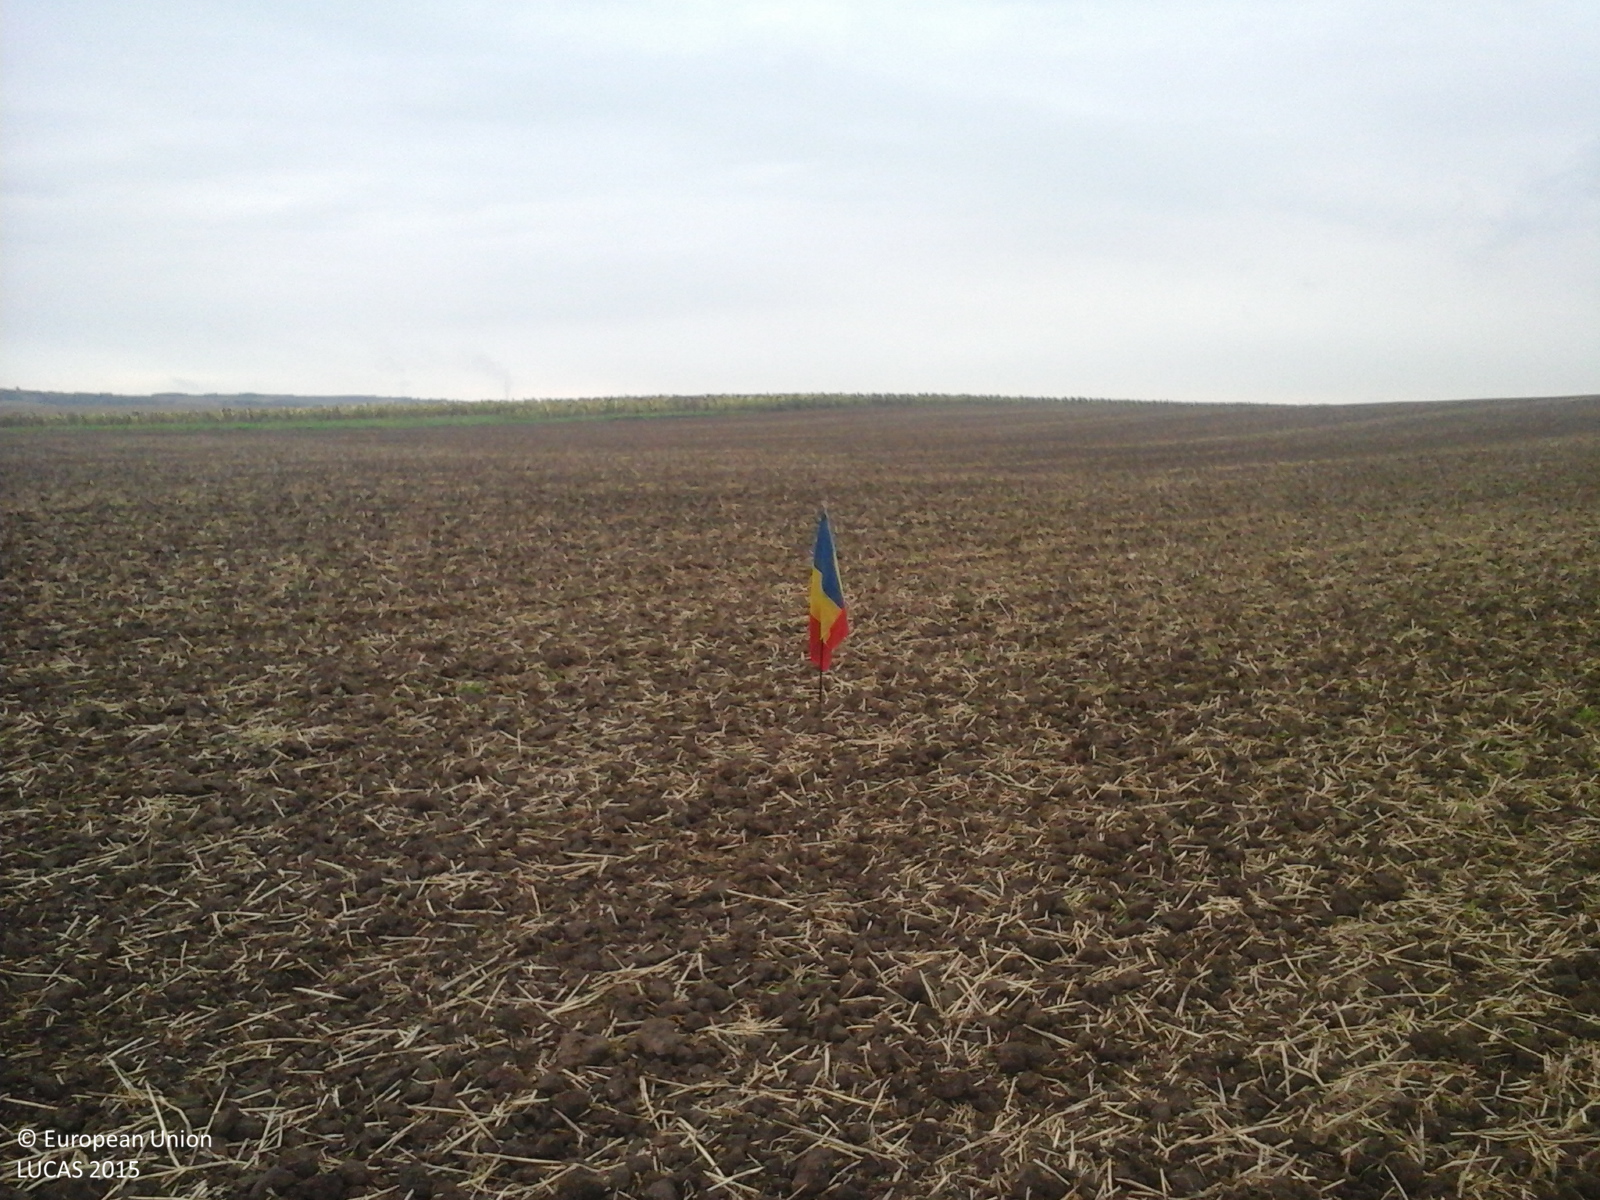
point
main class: Cropland
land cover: Common wheat
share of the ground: < 10 %
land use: Agriculture (excluding fallow land and kitchen gardens)
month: September
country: RO
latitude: 47.1843
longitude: 21.9907
